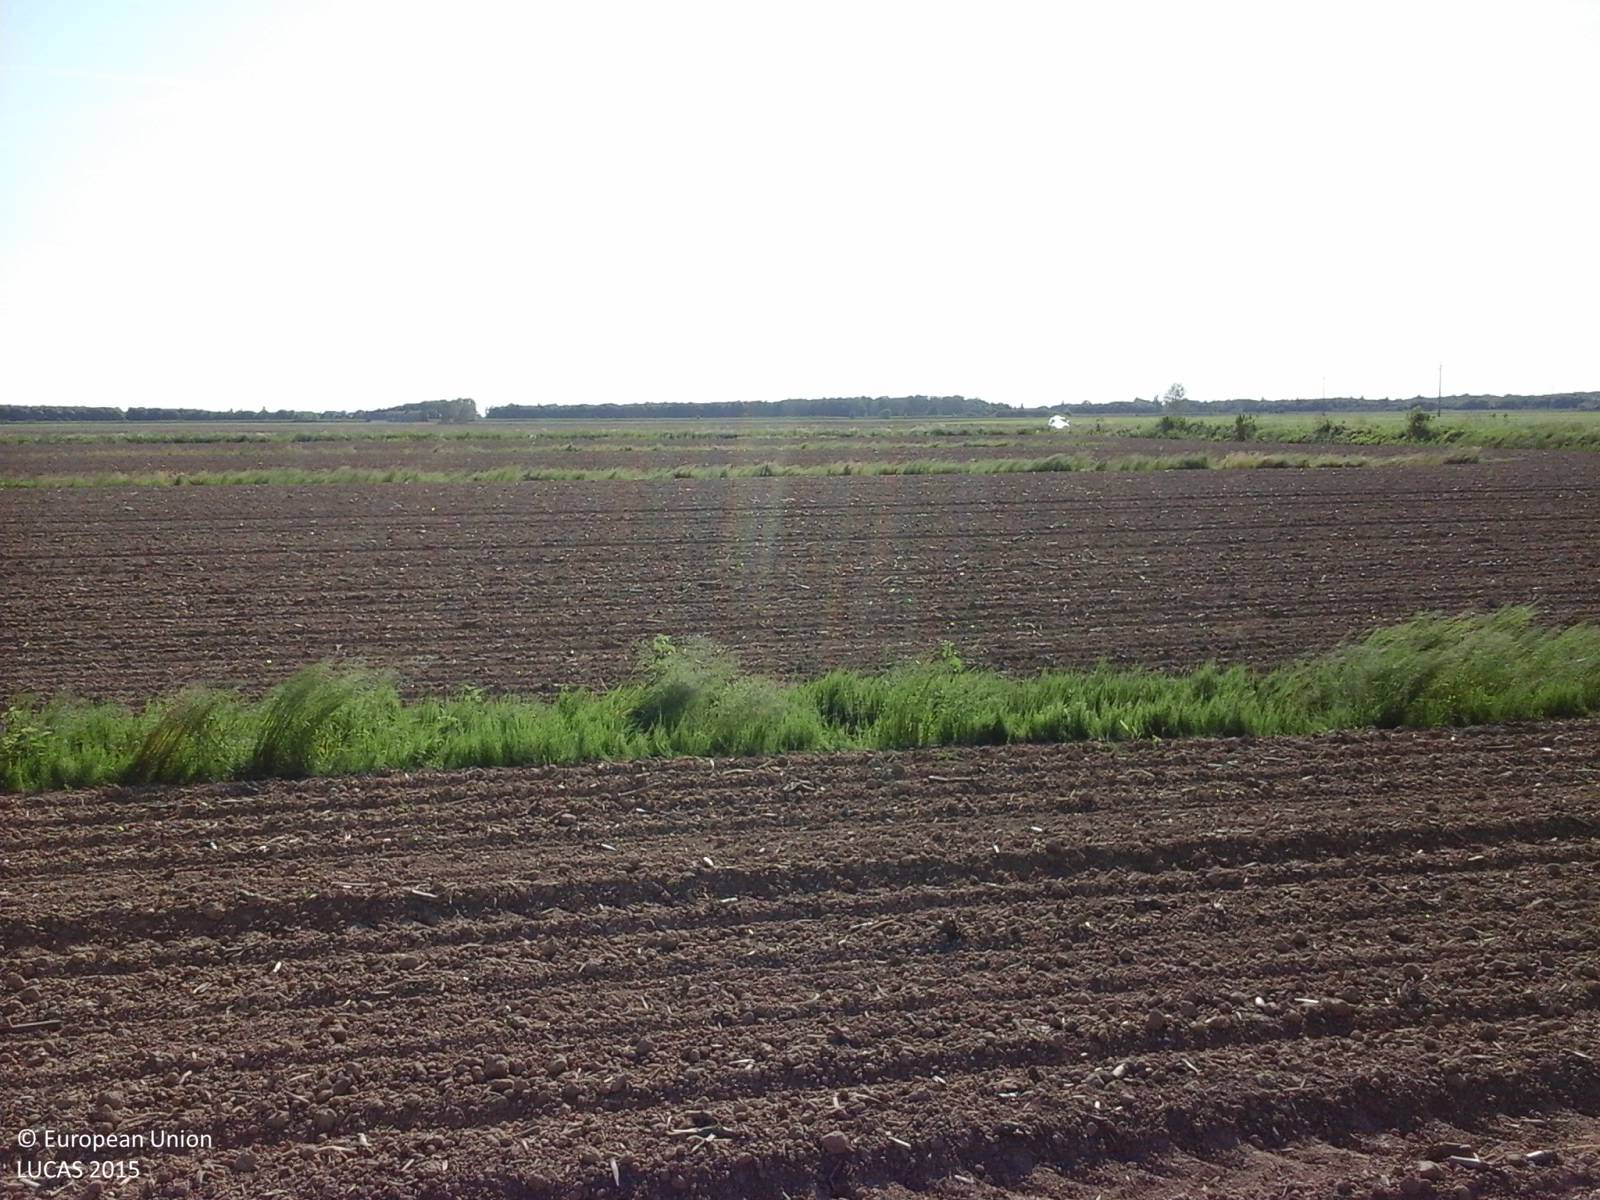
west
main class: Cropland
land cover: Soya
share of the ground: < 10 %
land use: Agriculture (excluding fallow land and kitchen gardens)
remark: Tilled/Sowed
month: May
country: IT
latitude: 45.7798
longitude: 13.2242
